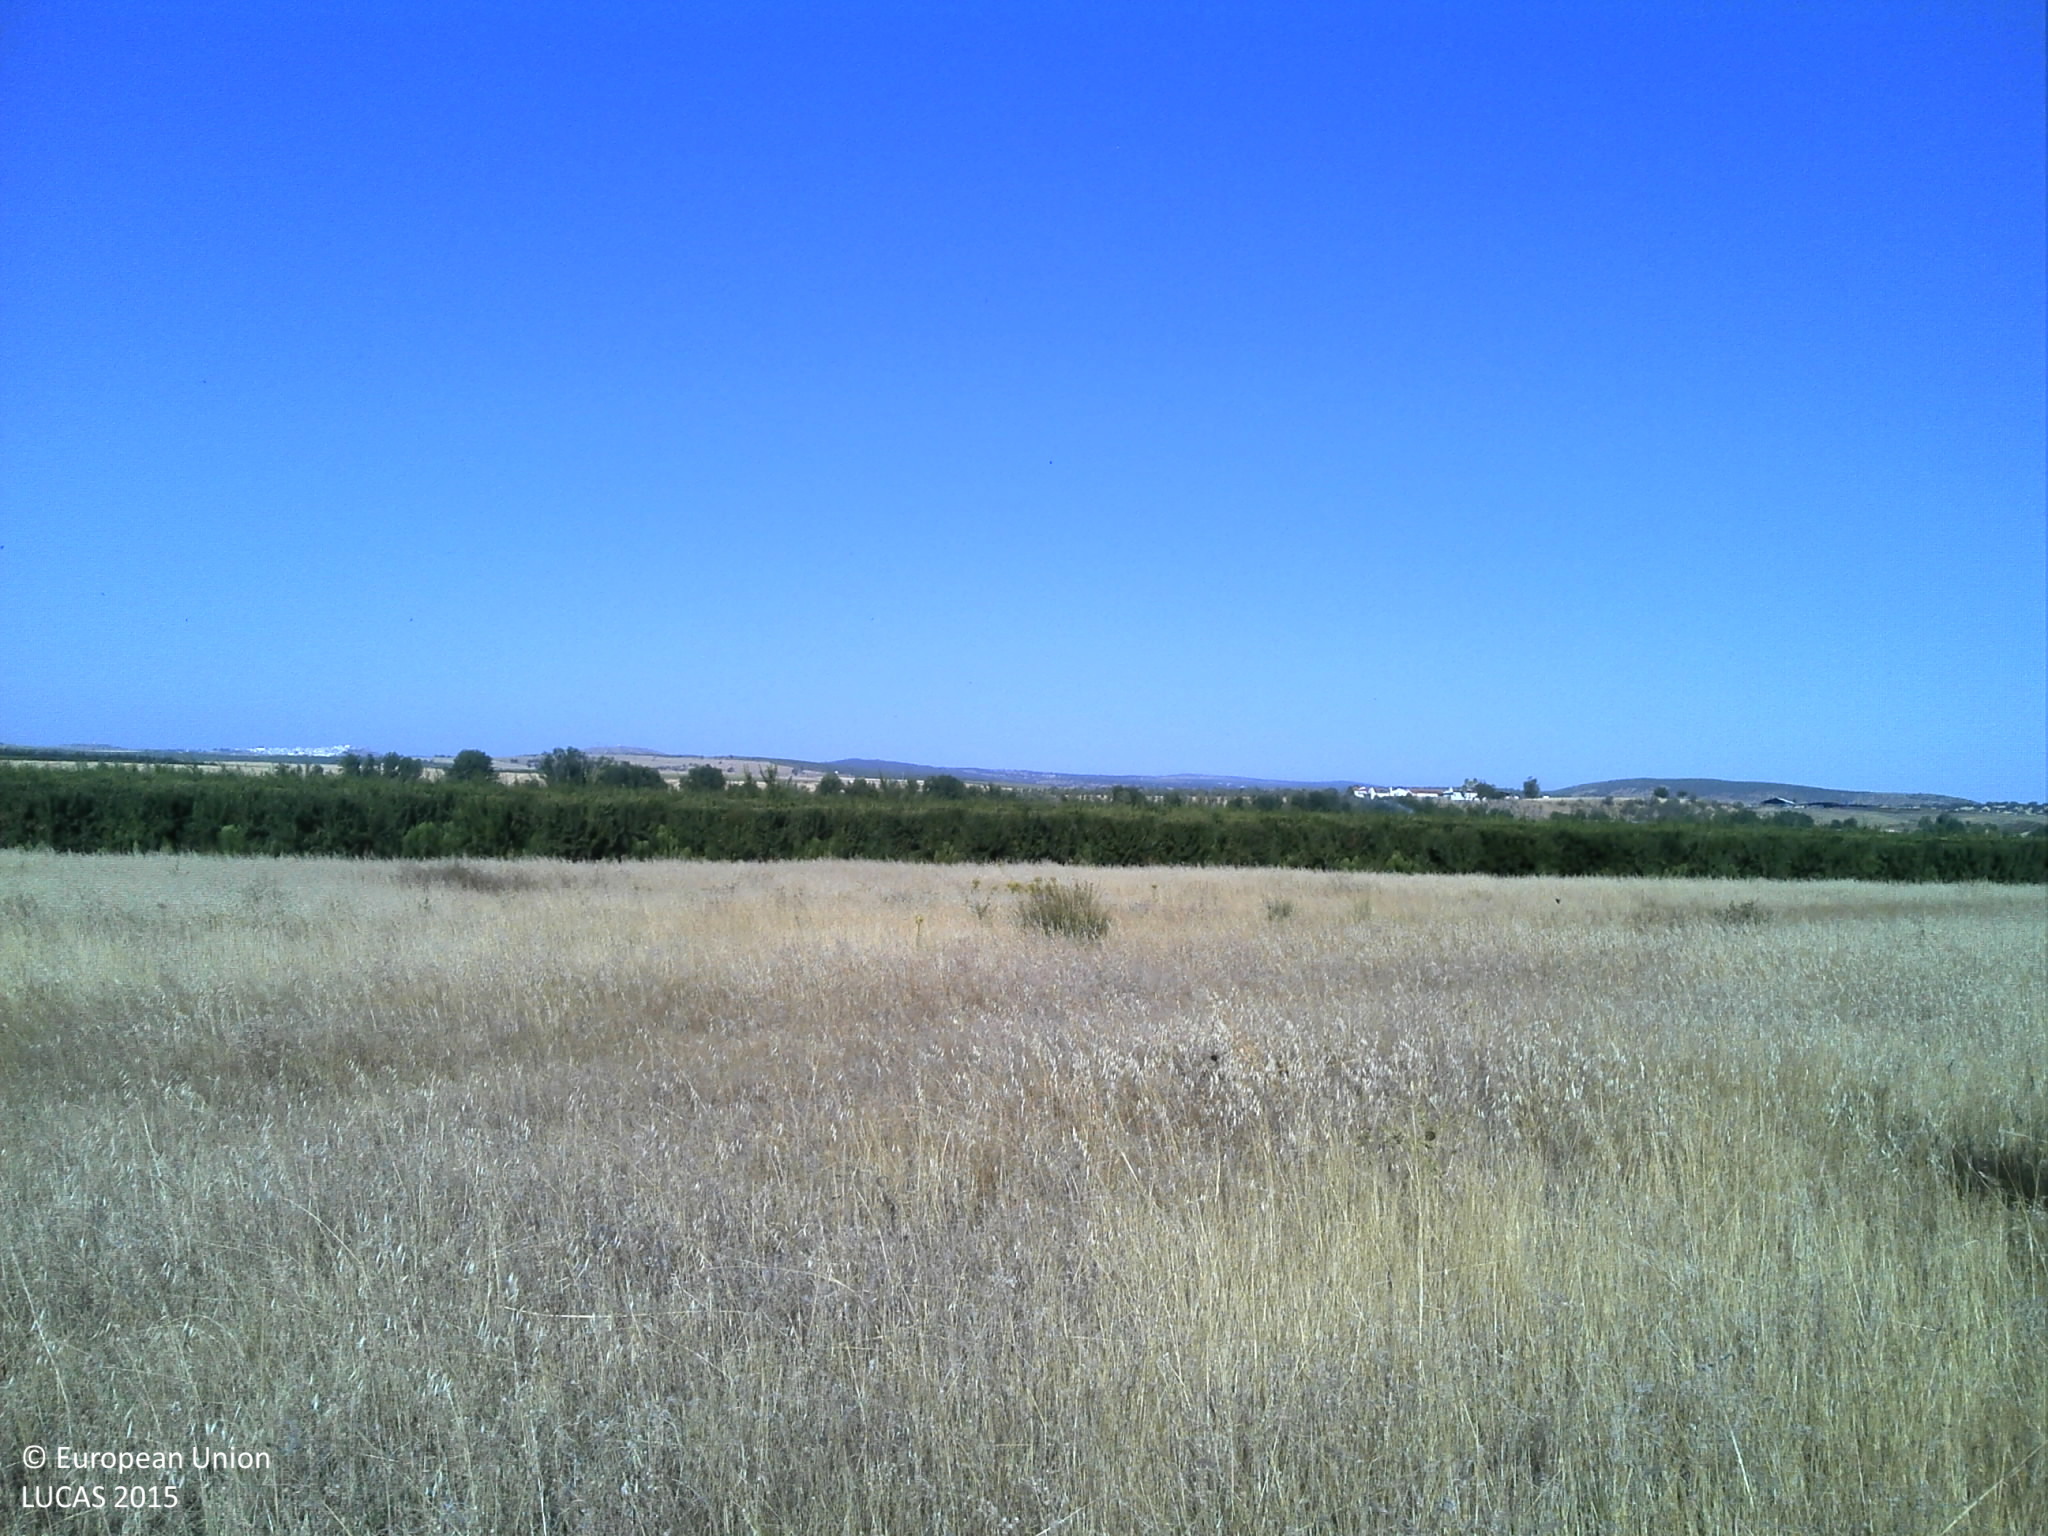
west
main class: Grassland
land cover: Grassland without tree/shrub cover
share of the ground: 50 - 75 %
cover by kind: herbaceous plants 75 %, unconsolidated bare surface 25 %
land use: Agriculture (excluding fallow land and kitchen gardens)
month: July
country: PT
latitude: 38.9261
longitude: -7.0633
